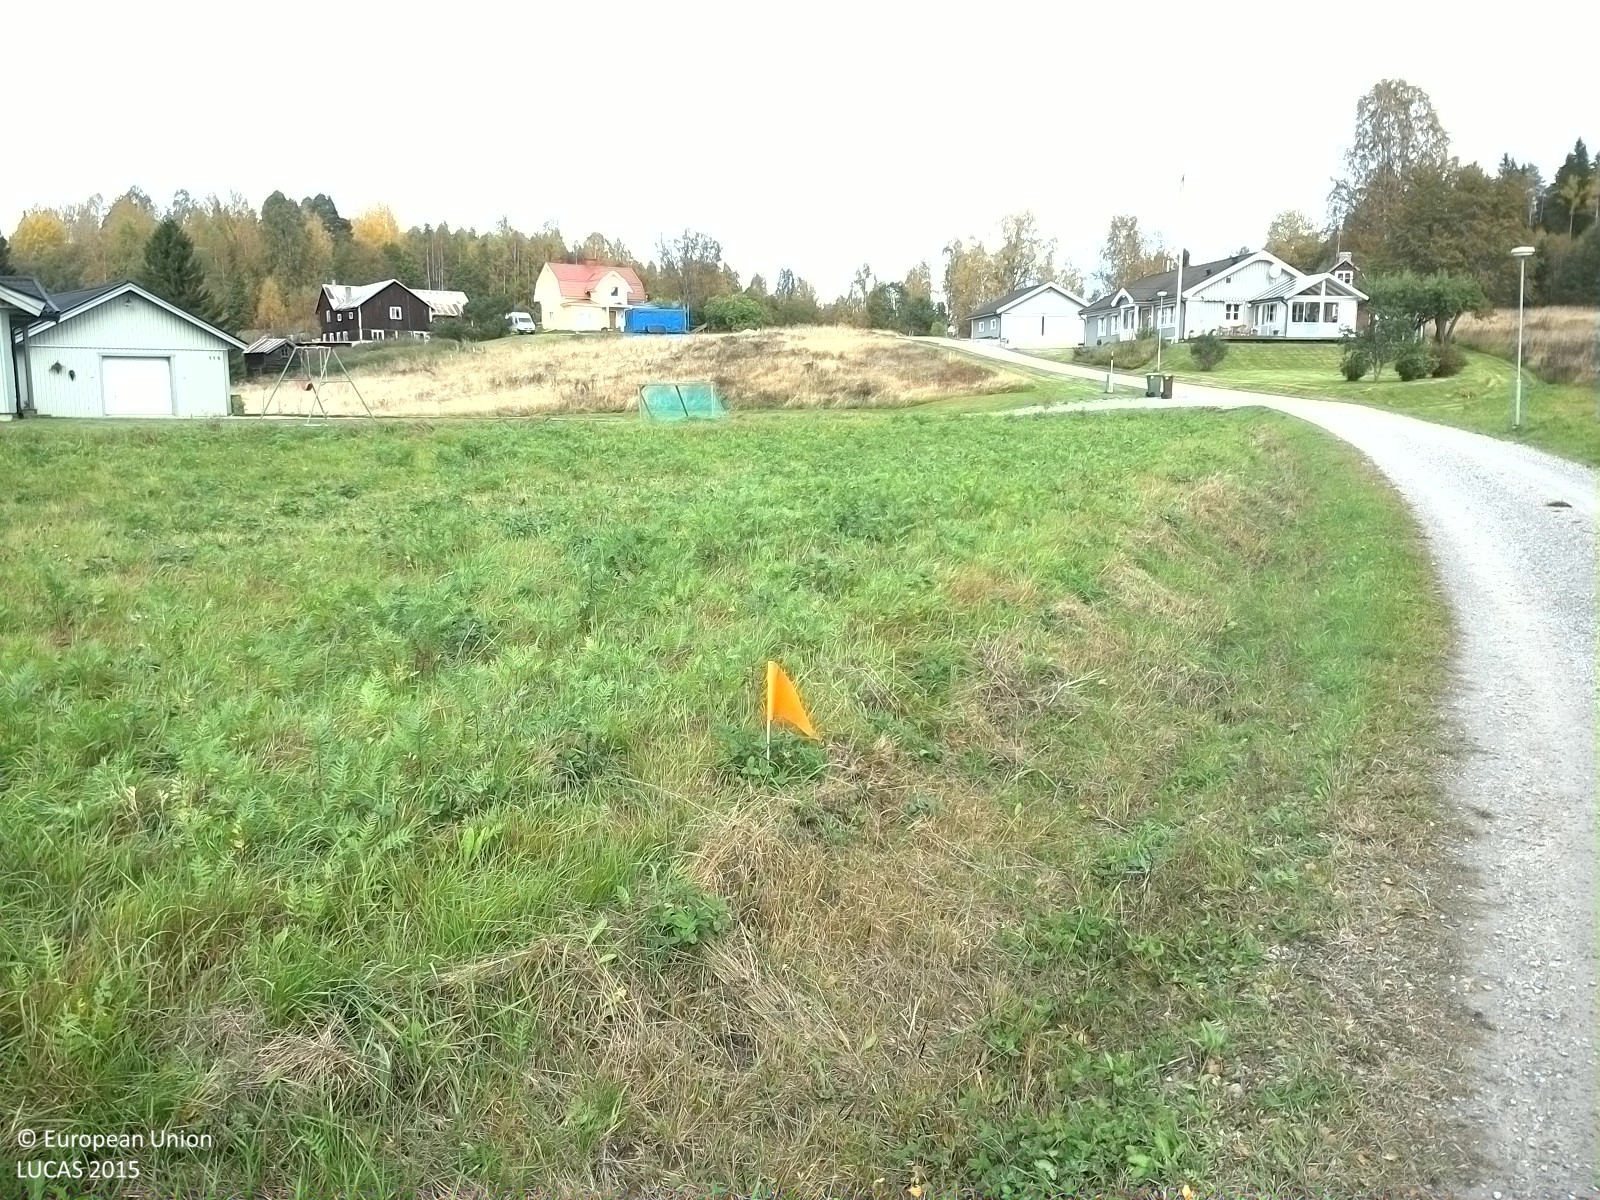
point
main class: Grassland
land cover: Grassland without tree/shrub cover
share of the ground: > 75 %
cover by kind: herbaceous plants 100 %
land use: Agriculture (excluding fallow land and kitchen gardens)
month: September
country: SE
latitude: 62.3144
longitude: 17.1769
